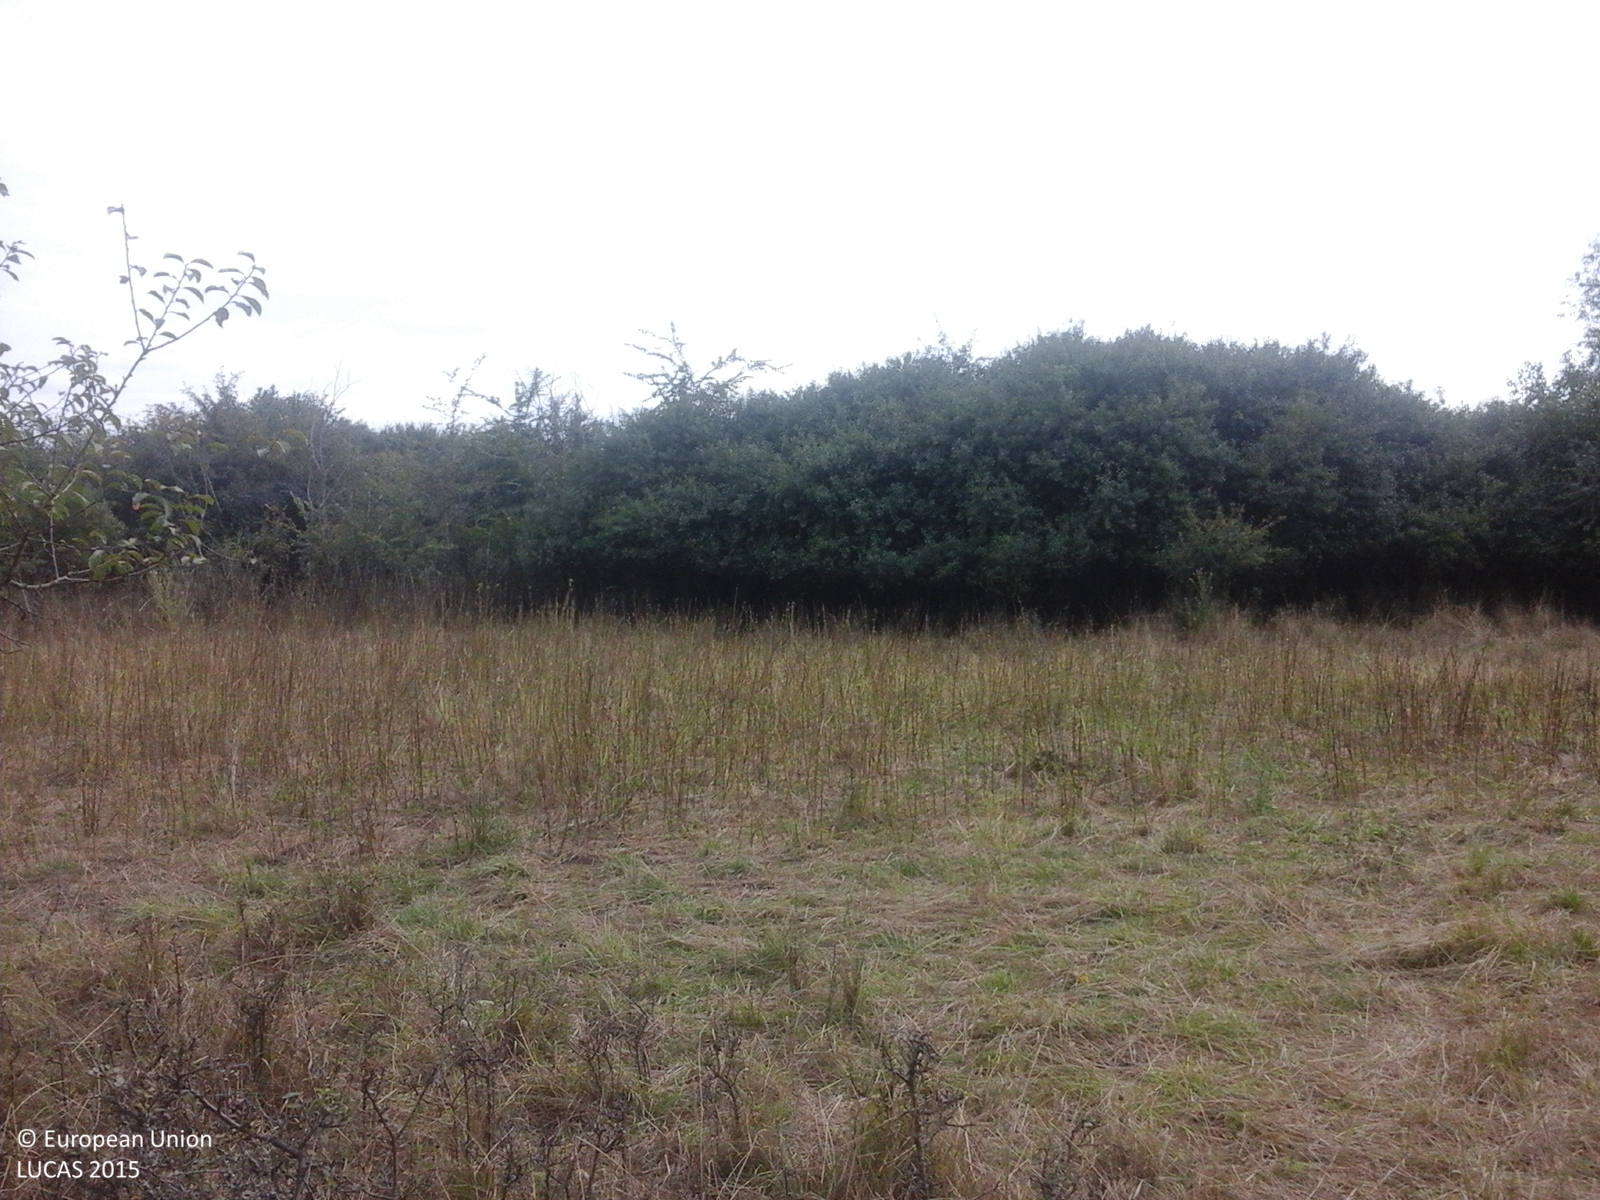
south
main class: Grassland
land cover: Grassland with sparse tree/shrub cover
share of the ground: > 75 %
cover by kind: herbaceous plants 85 %, shrubs 10 %, broadleaved forest trees 5 %
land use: Agriculture (excluding fallow land and kitchen gardens)
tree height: < 5 m
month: August
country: RO
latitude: 45.4215
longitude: 21.3143
